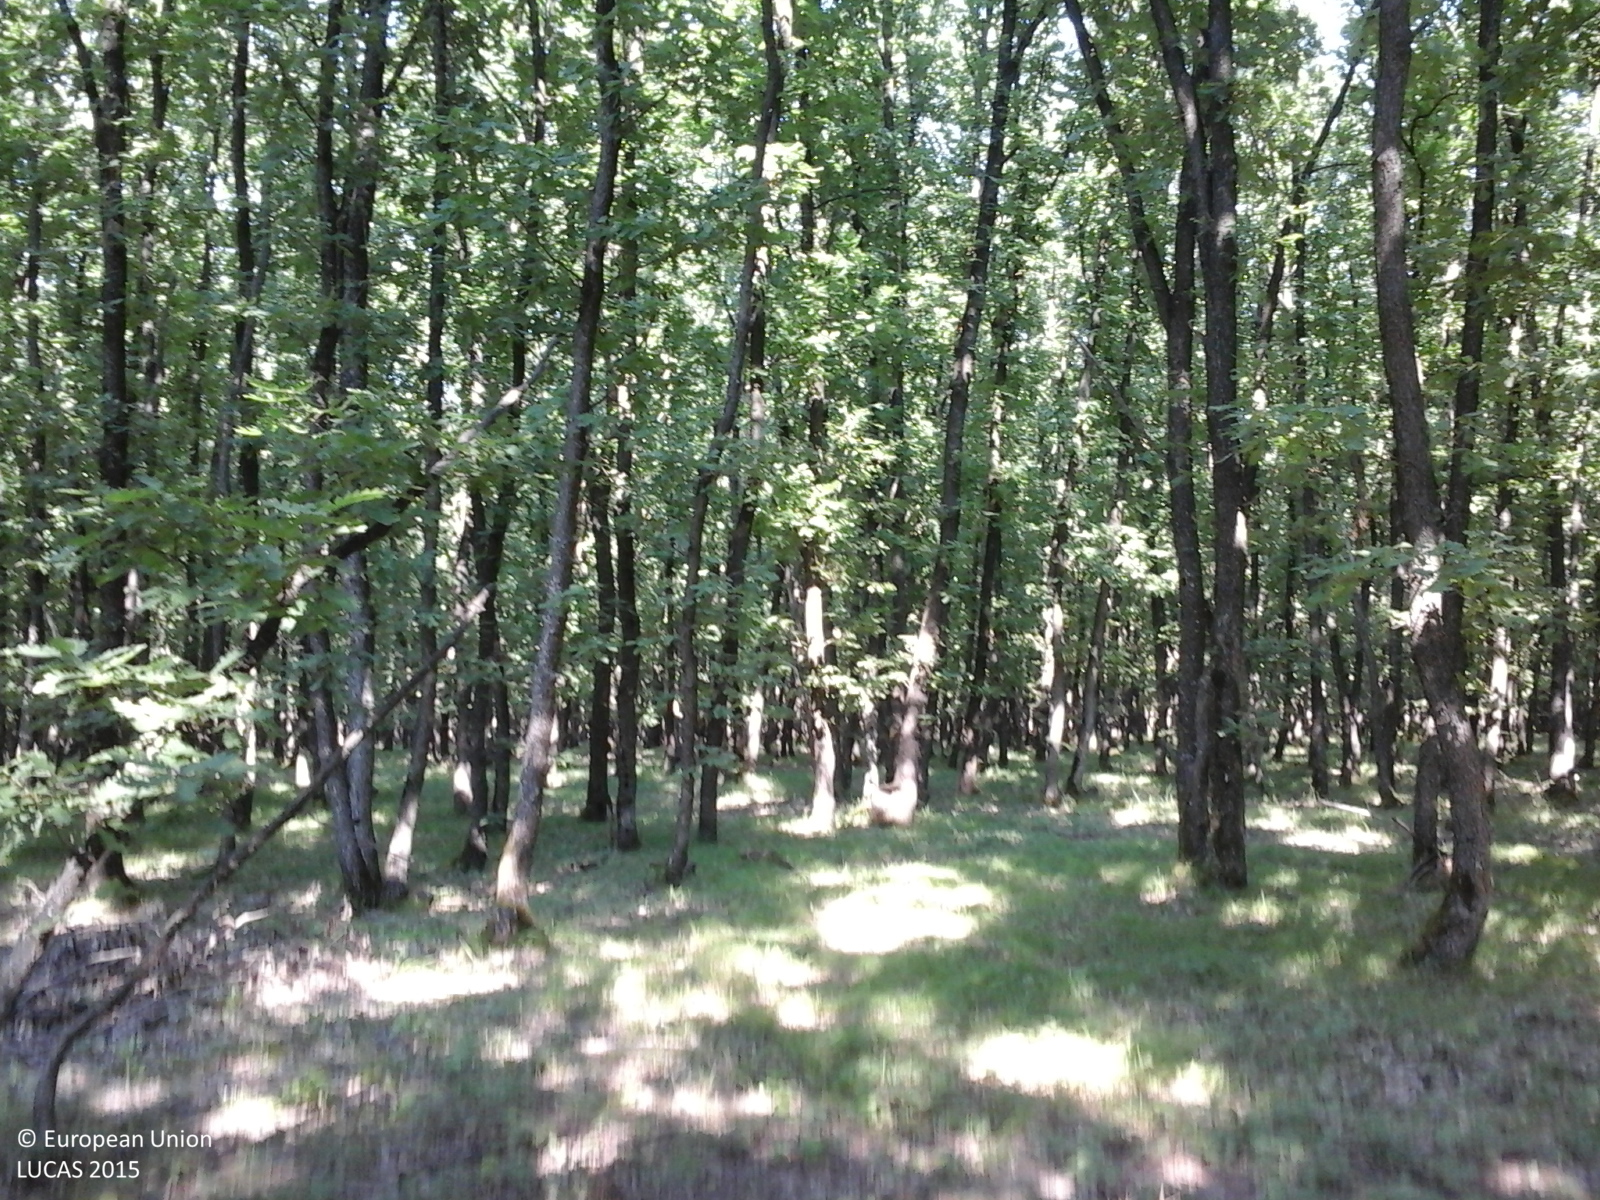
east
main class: Woodland
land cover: Broadleaved woodland
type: acidophilous oak and oak-birch forest
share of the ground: > 75 %
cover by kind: broadleaved forest trees 100 %
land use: Forestry
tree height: > 5 m
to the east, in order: Broadleaved woodland; Tracks; Broadleaved woodland
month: July
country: RO
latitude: 44.7022
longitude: 24.6012
